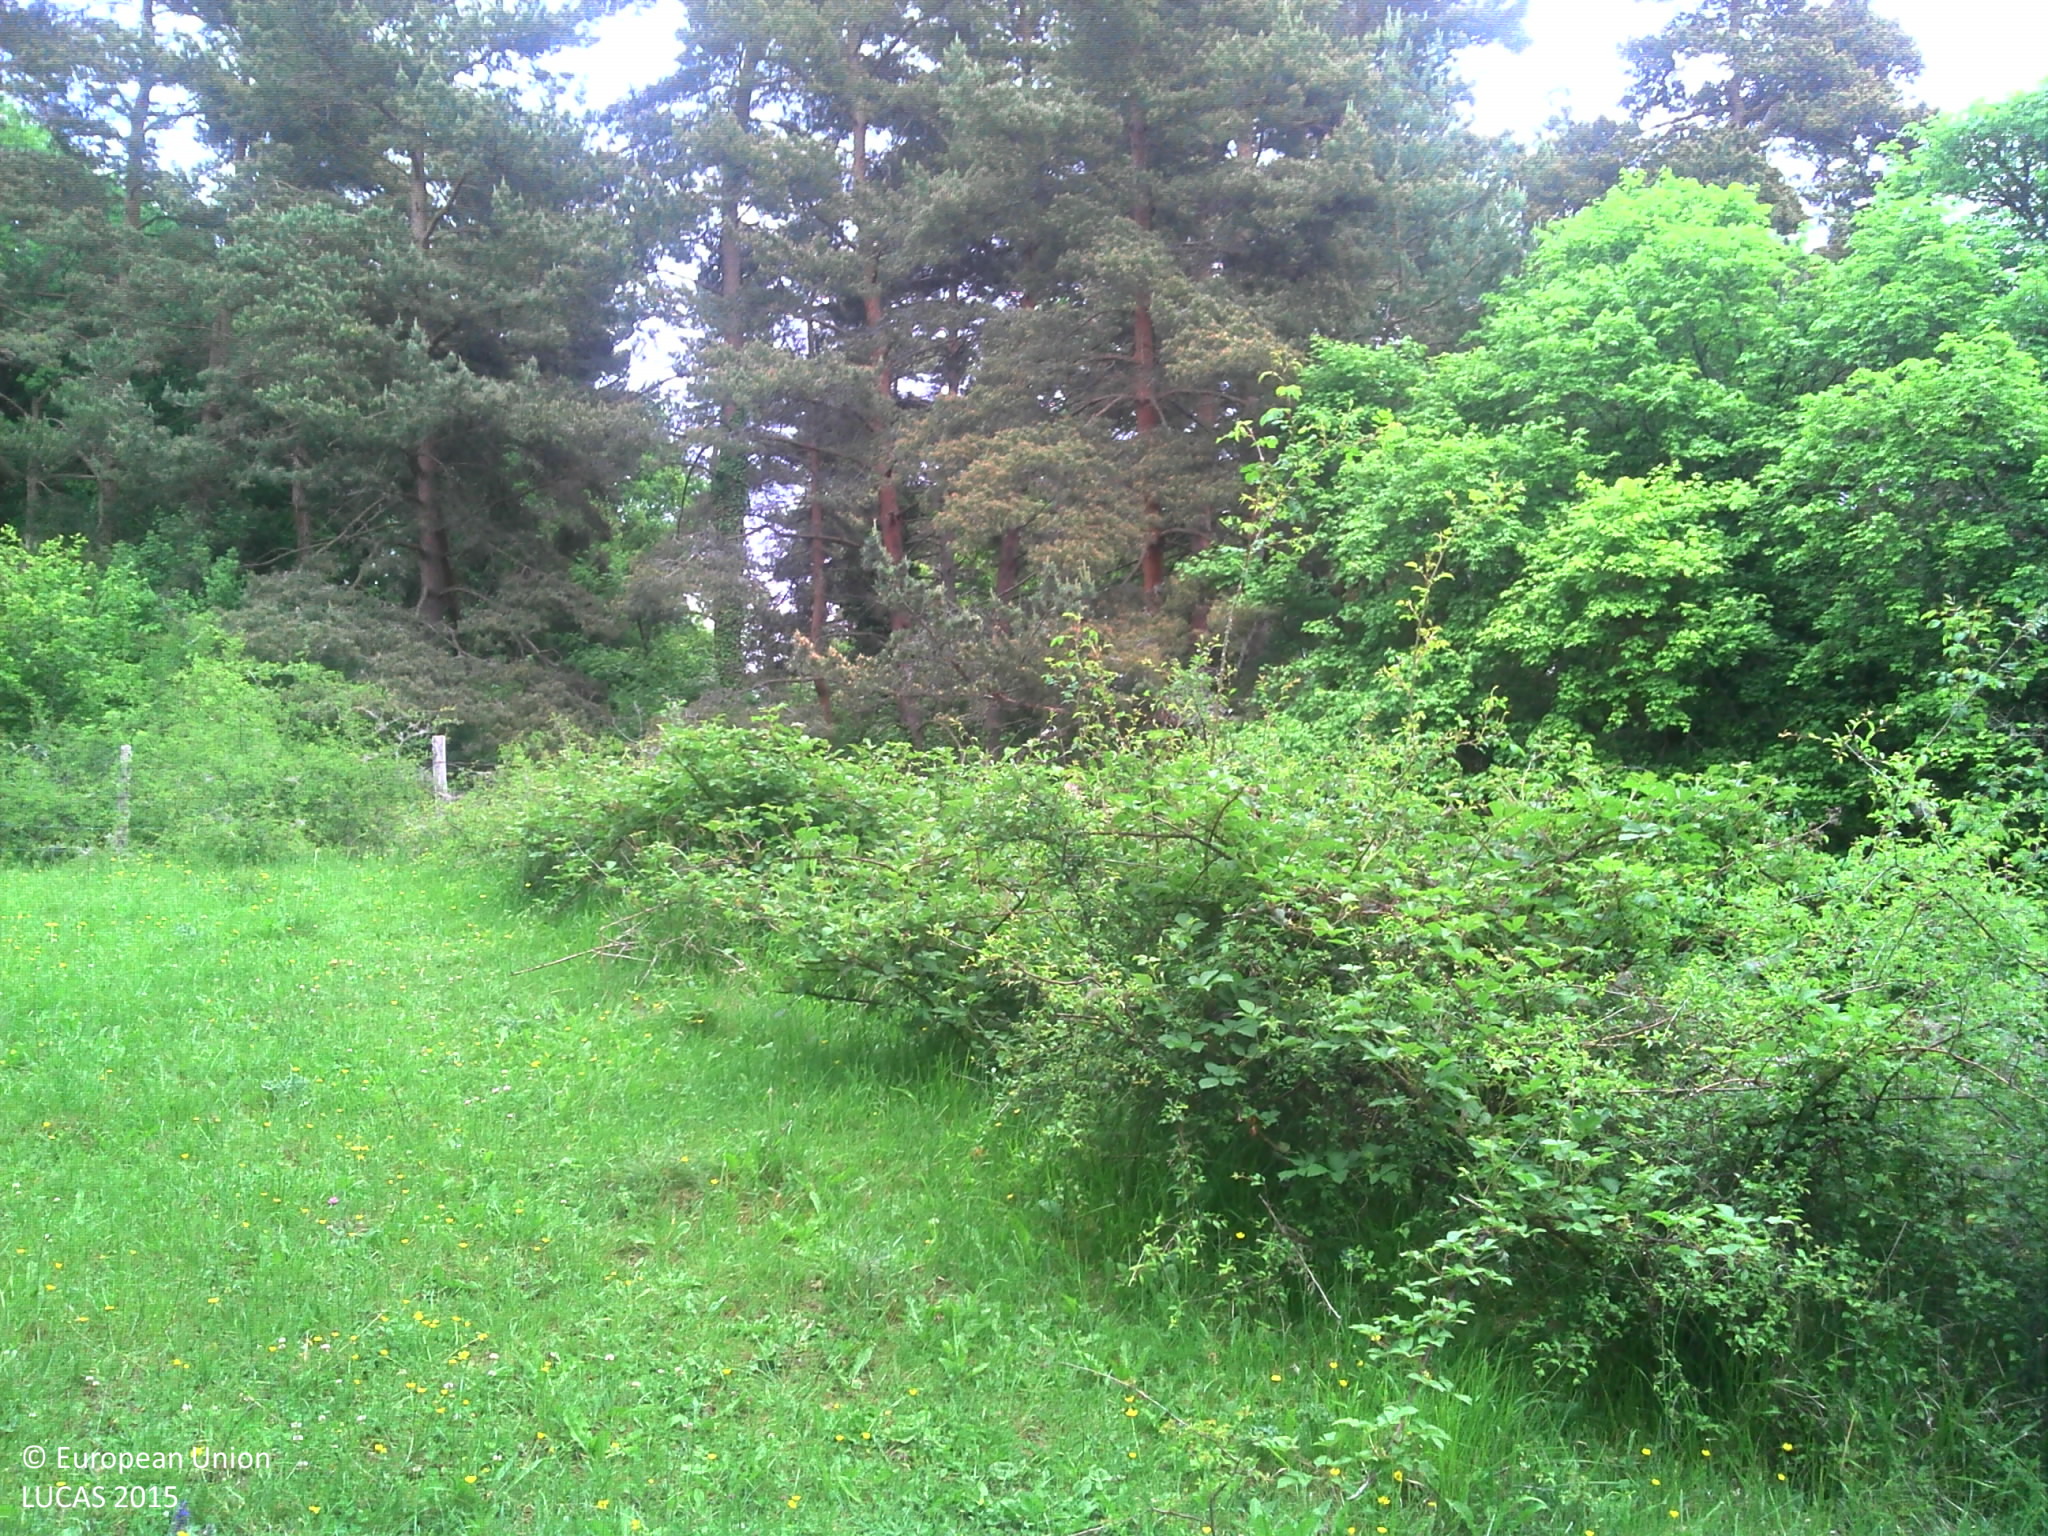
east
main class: Woodland
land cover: Pine dominated mixed woodland
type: alpine coniferous forest
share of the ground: 50 - 75 %
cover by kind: coniferous forest trees 50 %, broadleaved forest trees 20 %, herbaceous plants 20 %, shrubs 10 %
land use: Forestry
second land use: Agriculture (excluding fallow land and kitchen gardens)
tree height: > 5 m
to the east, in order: Pine dominated mixed woodland; Grassland without tree/shrub cover; Rocks and stones; Fences; Rocks and stones; Pine dominated mixed woodland; Broadleaved woodland; Shrubland with sparse tree cover; Broadleaved woodland; Fences; Broadleaved woodland; Shrubland with sparse tree cover
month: June
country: FR
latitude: 45.0457
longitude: 3.1338
